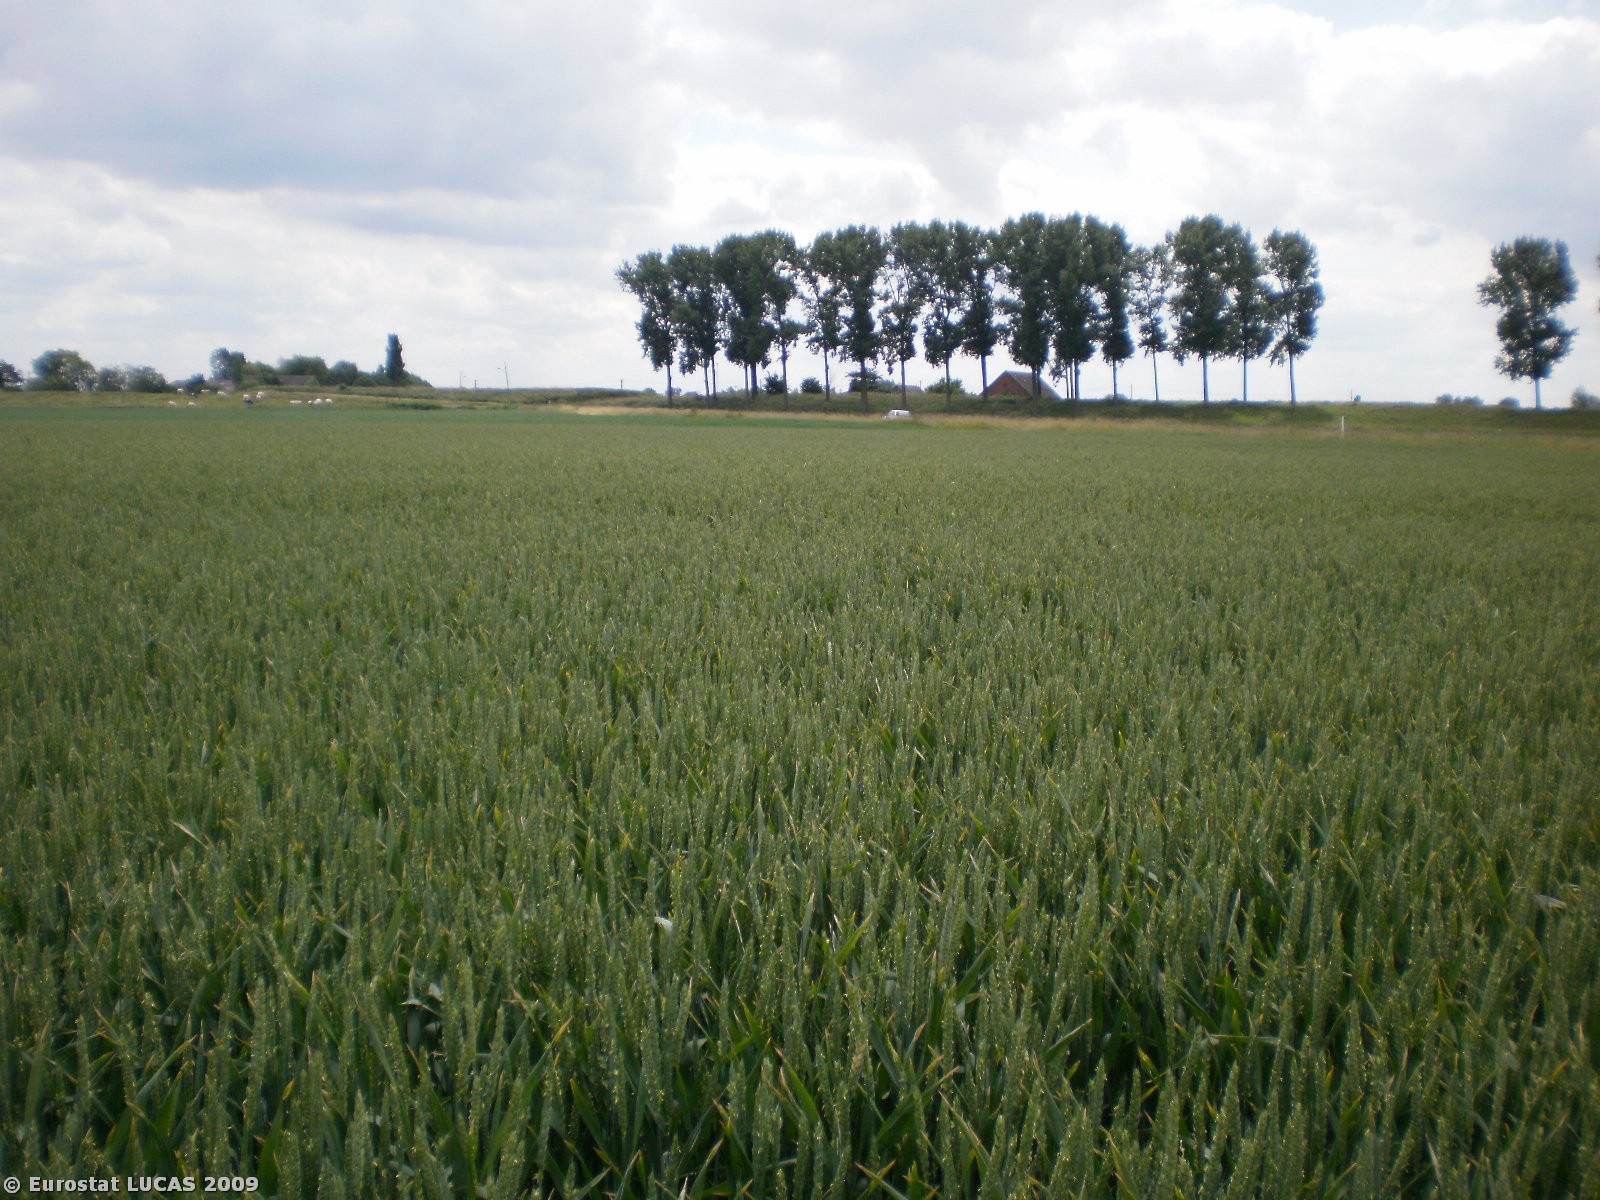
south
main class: Cropland
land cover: Common wheat
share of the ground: > 75 %
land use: Agriculture (excluding fallow land and kitchen gardens)
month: June
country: BE
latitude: 51.3172
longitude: 4.2126
